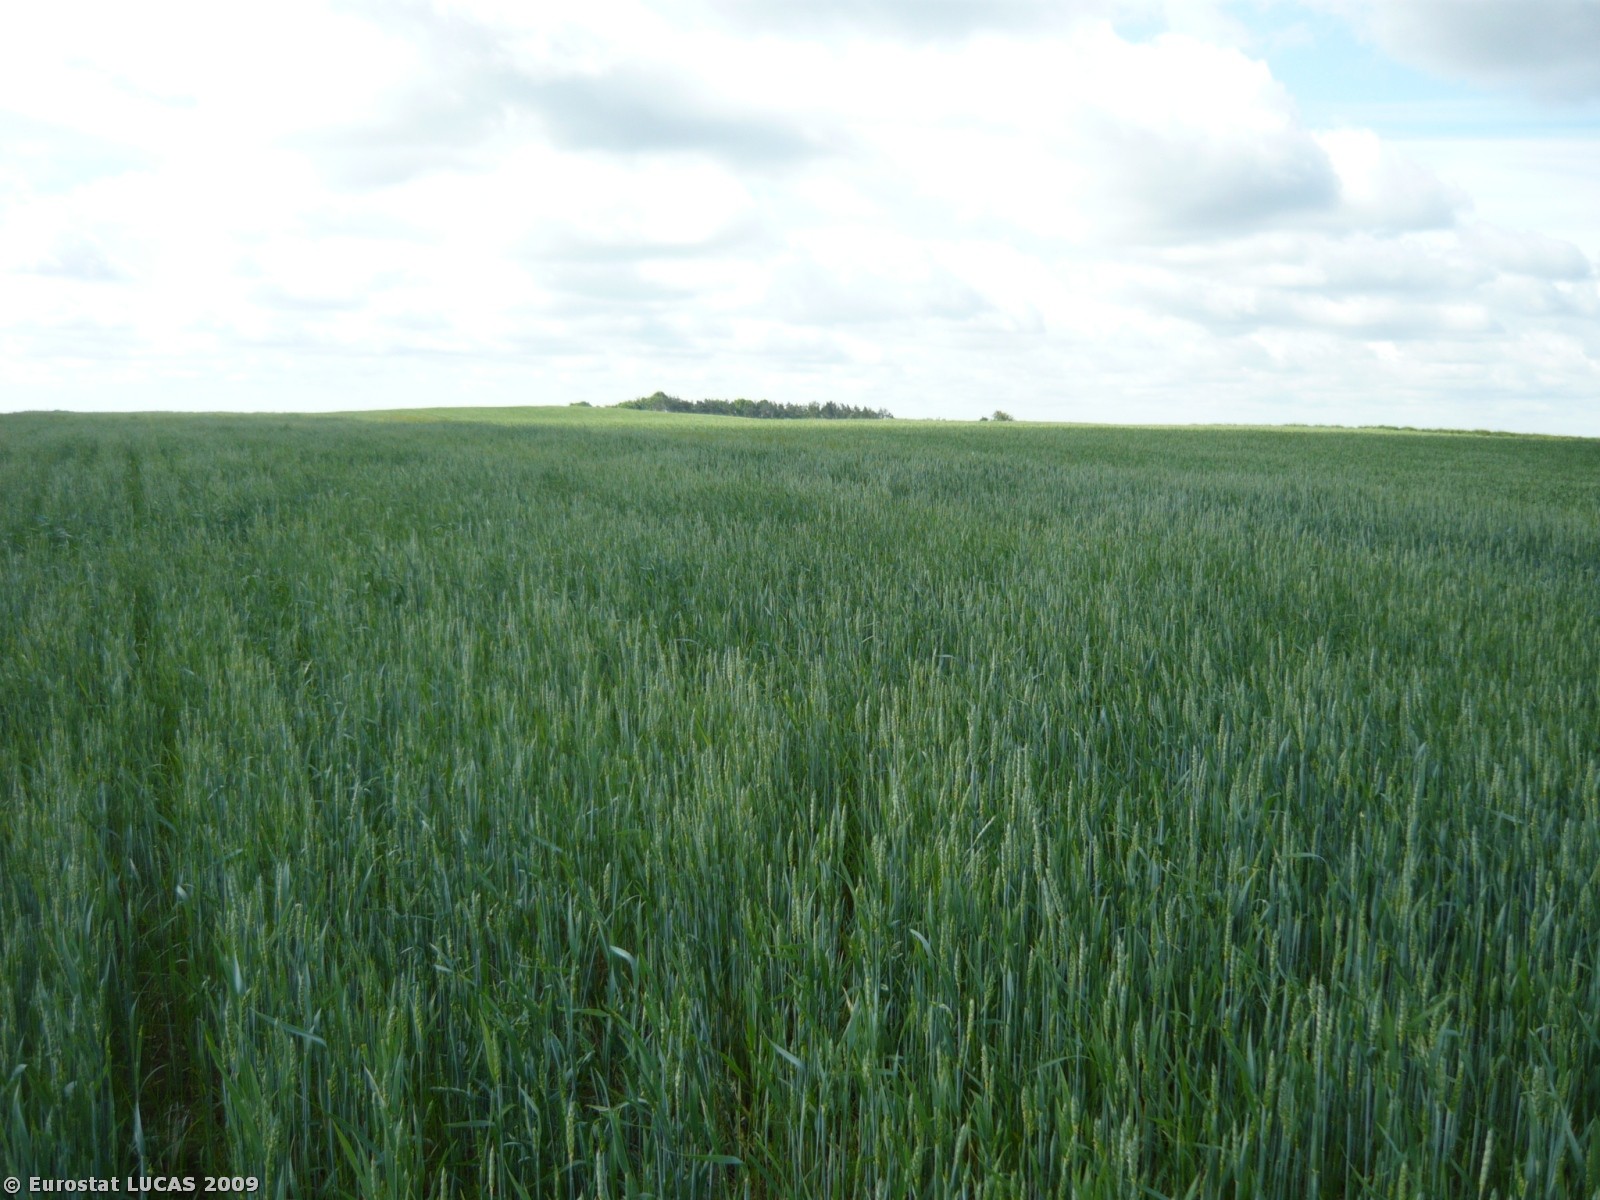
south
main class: Cropland
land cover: Common wheat
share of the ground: > 75 %
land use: Agriculture (excluding fallow land and kitchen gardens)
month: June
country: PL
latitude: 50.6685
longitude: 23.8289
